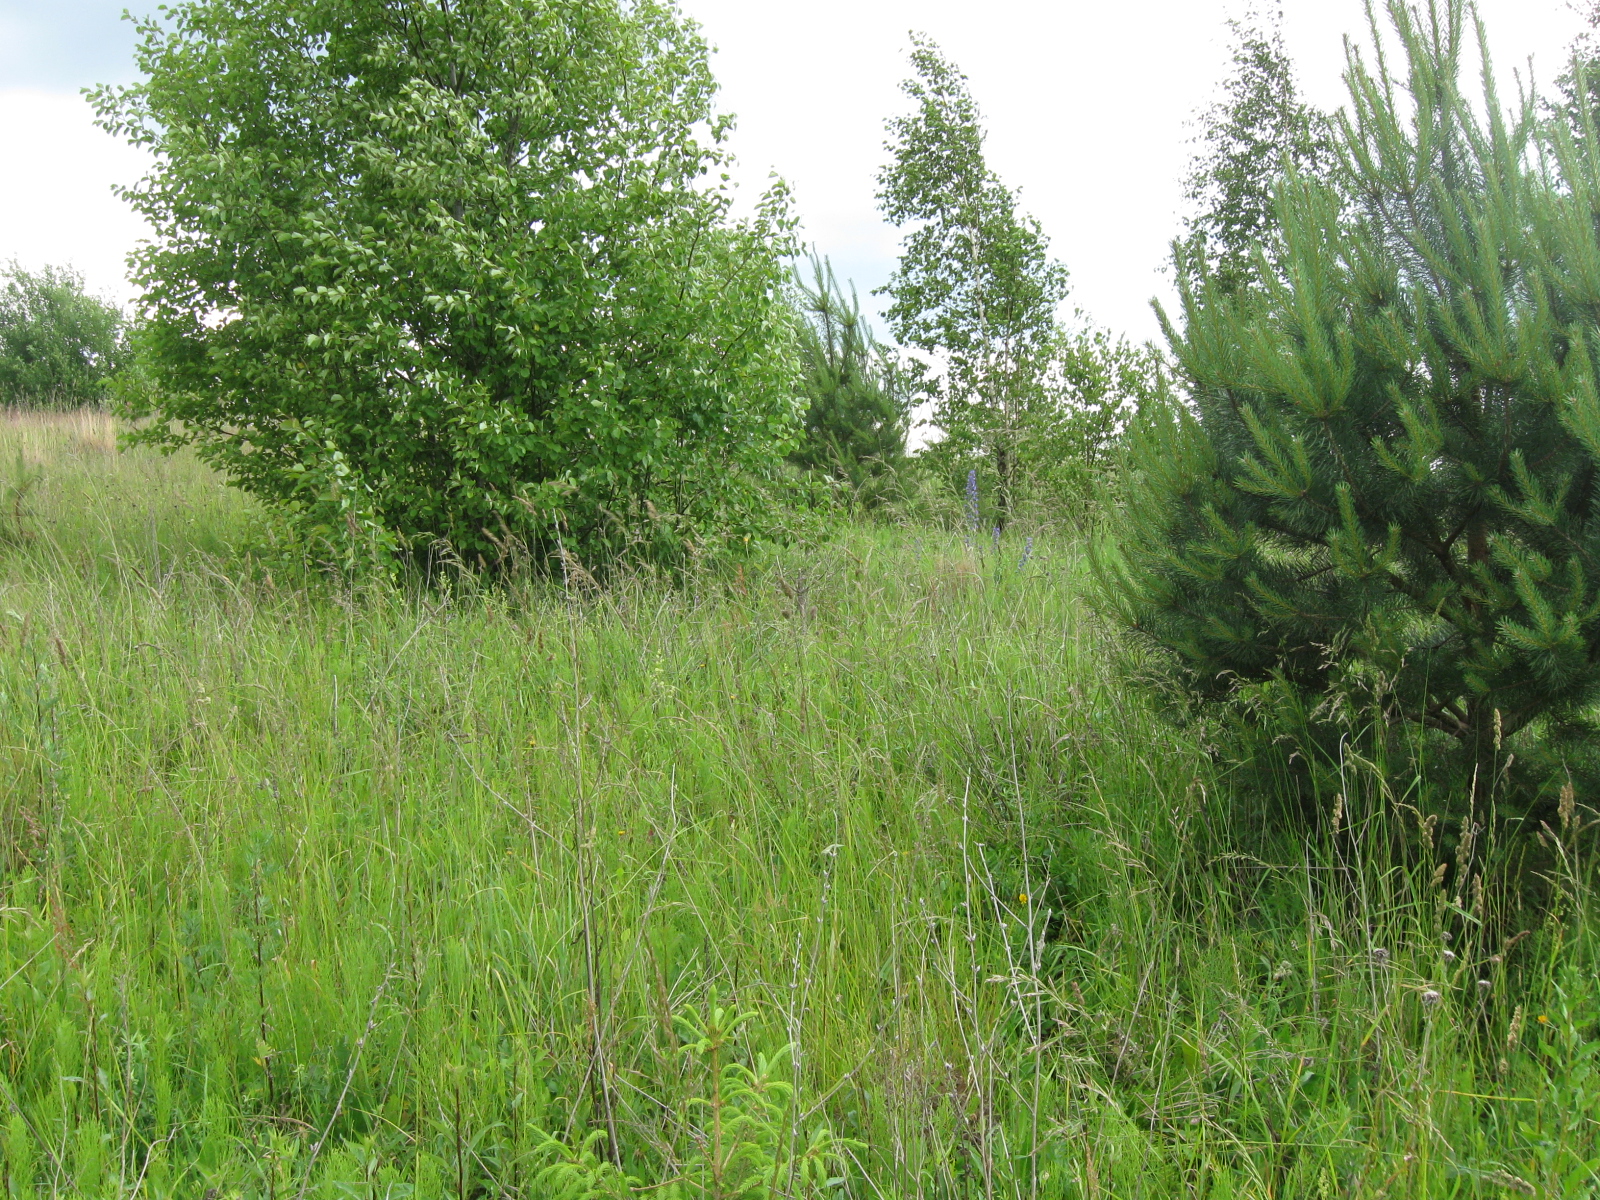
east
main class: Grassland
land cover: Grassland with sparse tree/shrub cover
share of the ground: > 75 %
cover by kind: herbaceous plants 90 %, broadleaved forest trees 5 %, shrubs 5 %
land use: Agriculture (excluding fallow land and kitchen gardens)
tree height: < 5 m
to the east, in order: Grassland with sparse tree/shrub cover; Shrubland with sparse tree cover; Grassland without tree/shrub cover; Oats; Lines of trees; Spontaneously vegetated surfaces; Tracks; Grassland without tree/shrub cover; Electric lines; Grassland without tree/shrub cover
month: June
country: LT
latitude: 54.5638
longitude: 24.4064
